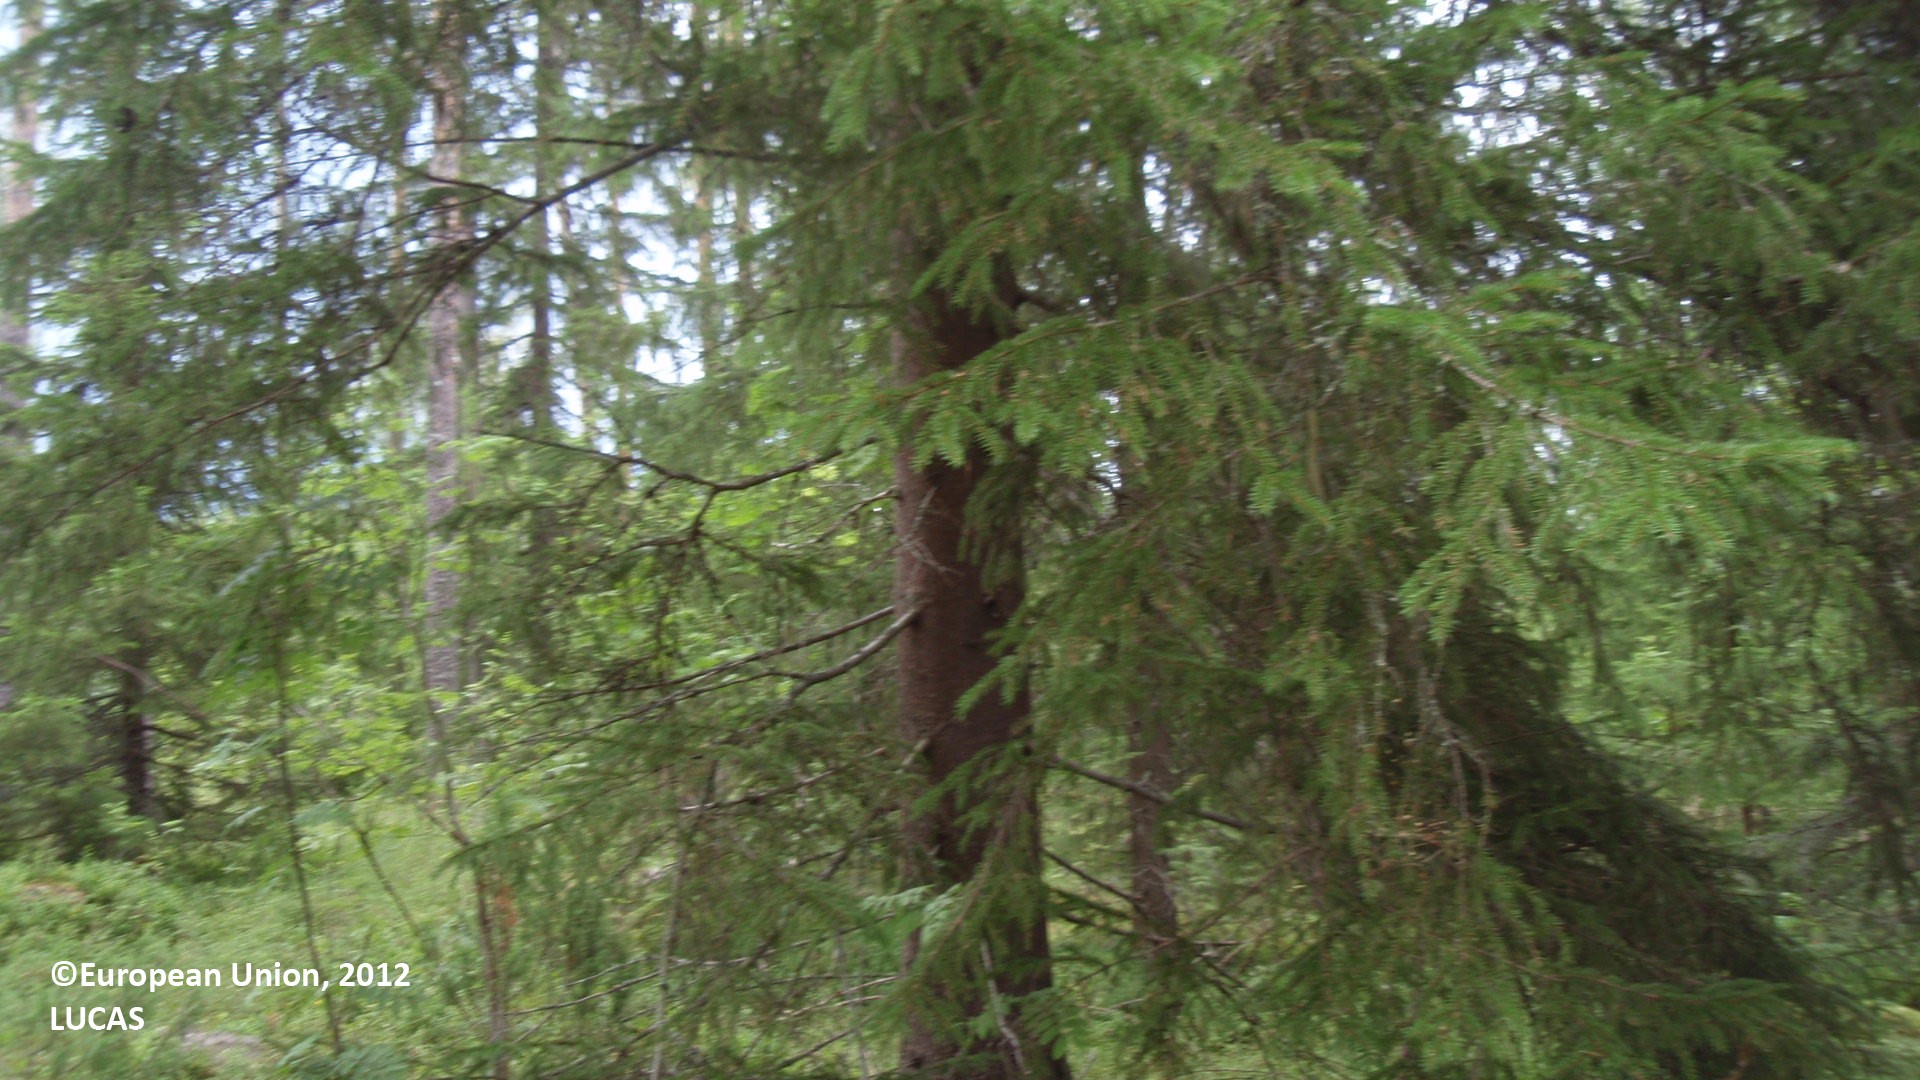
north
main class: Woodland
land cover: Pine dominated mixed woodland
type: boreal forest
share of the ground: 50 - 75 %
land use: Forestry
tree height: > 5 m
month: August
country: FI
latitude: 61.2451
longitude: 27.7609
